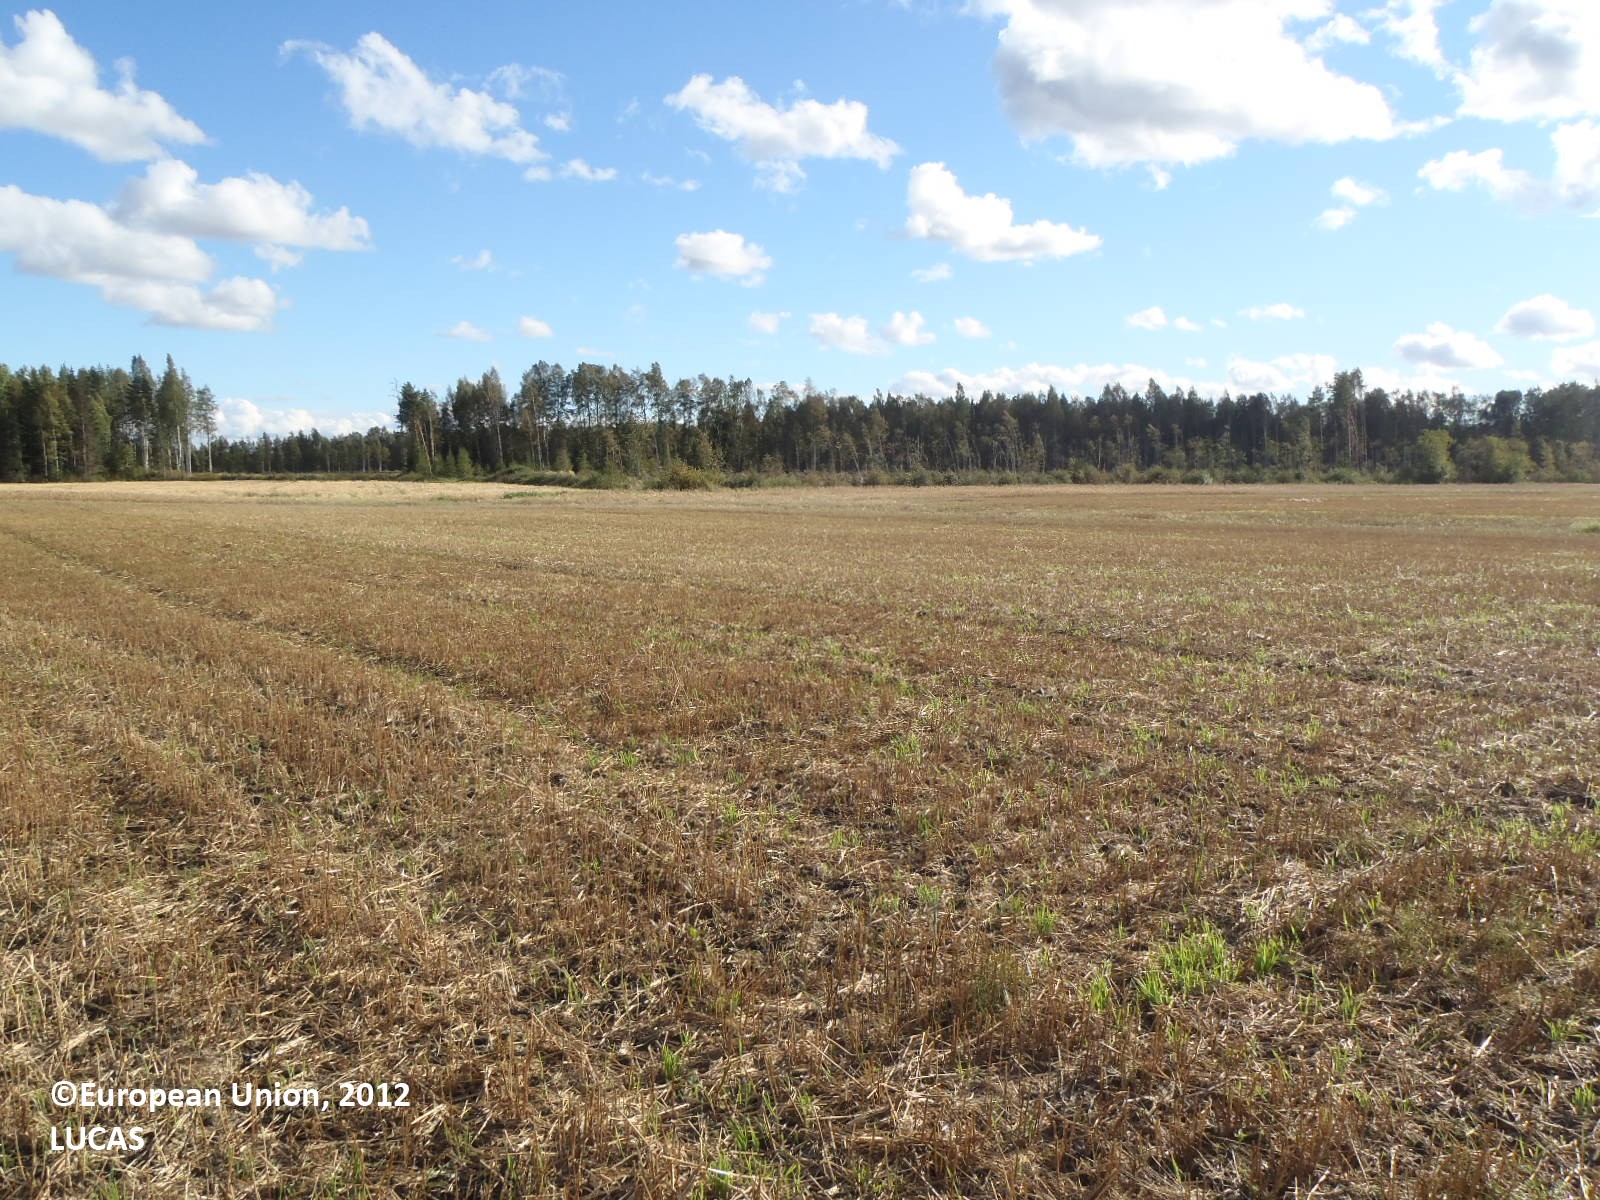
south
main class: Cropland
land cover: Barley
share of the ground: 50 - 75 %
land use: Agriculture (excluding fallow land and kitchen gardens)
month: September
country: FI
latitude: 61.2867
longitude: 22.4729
